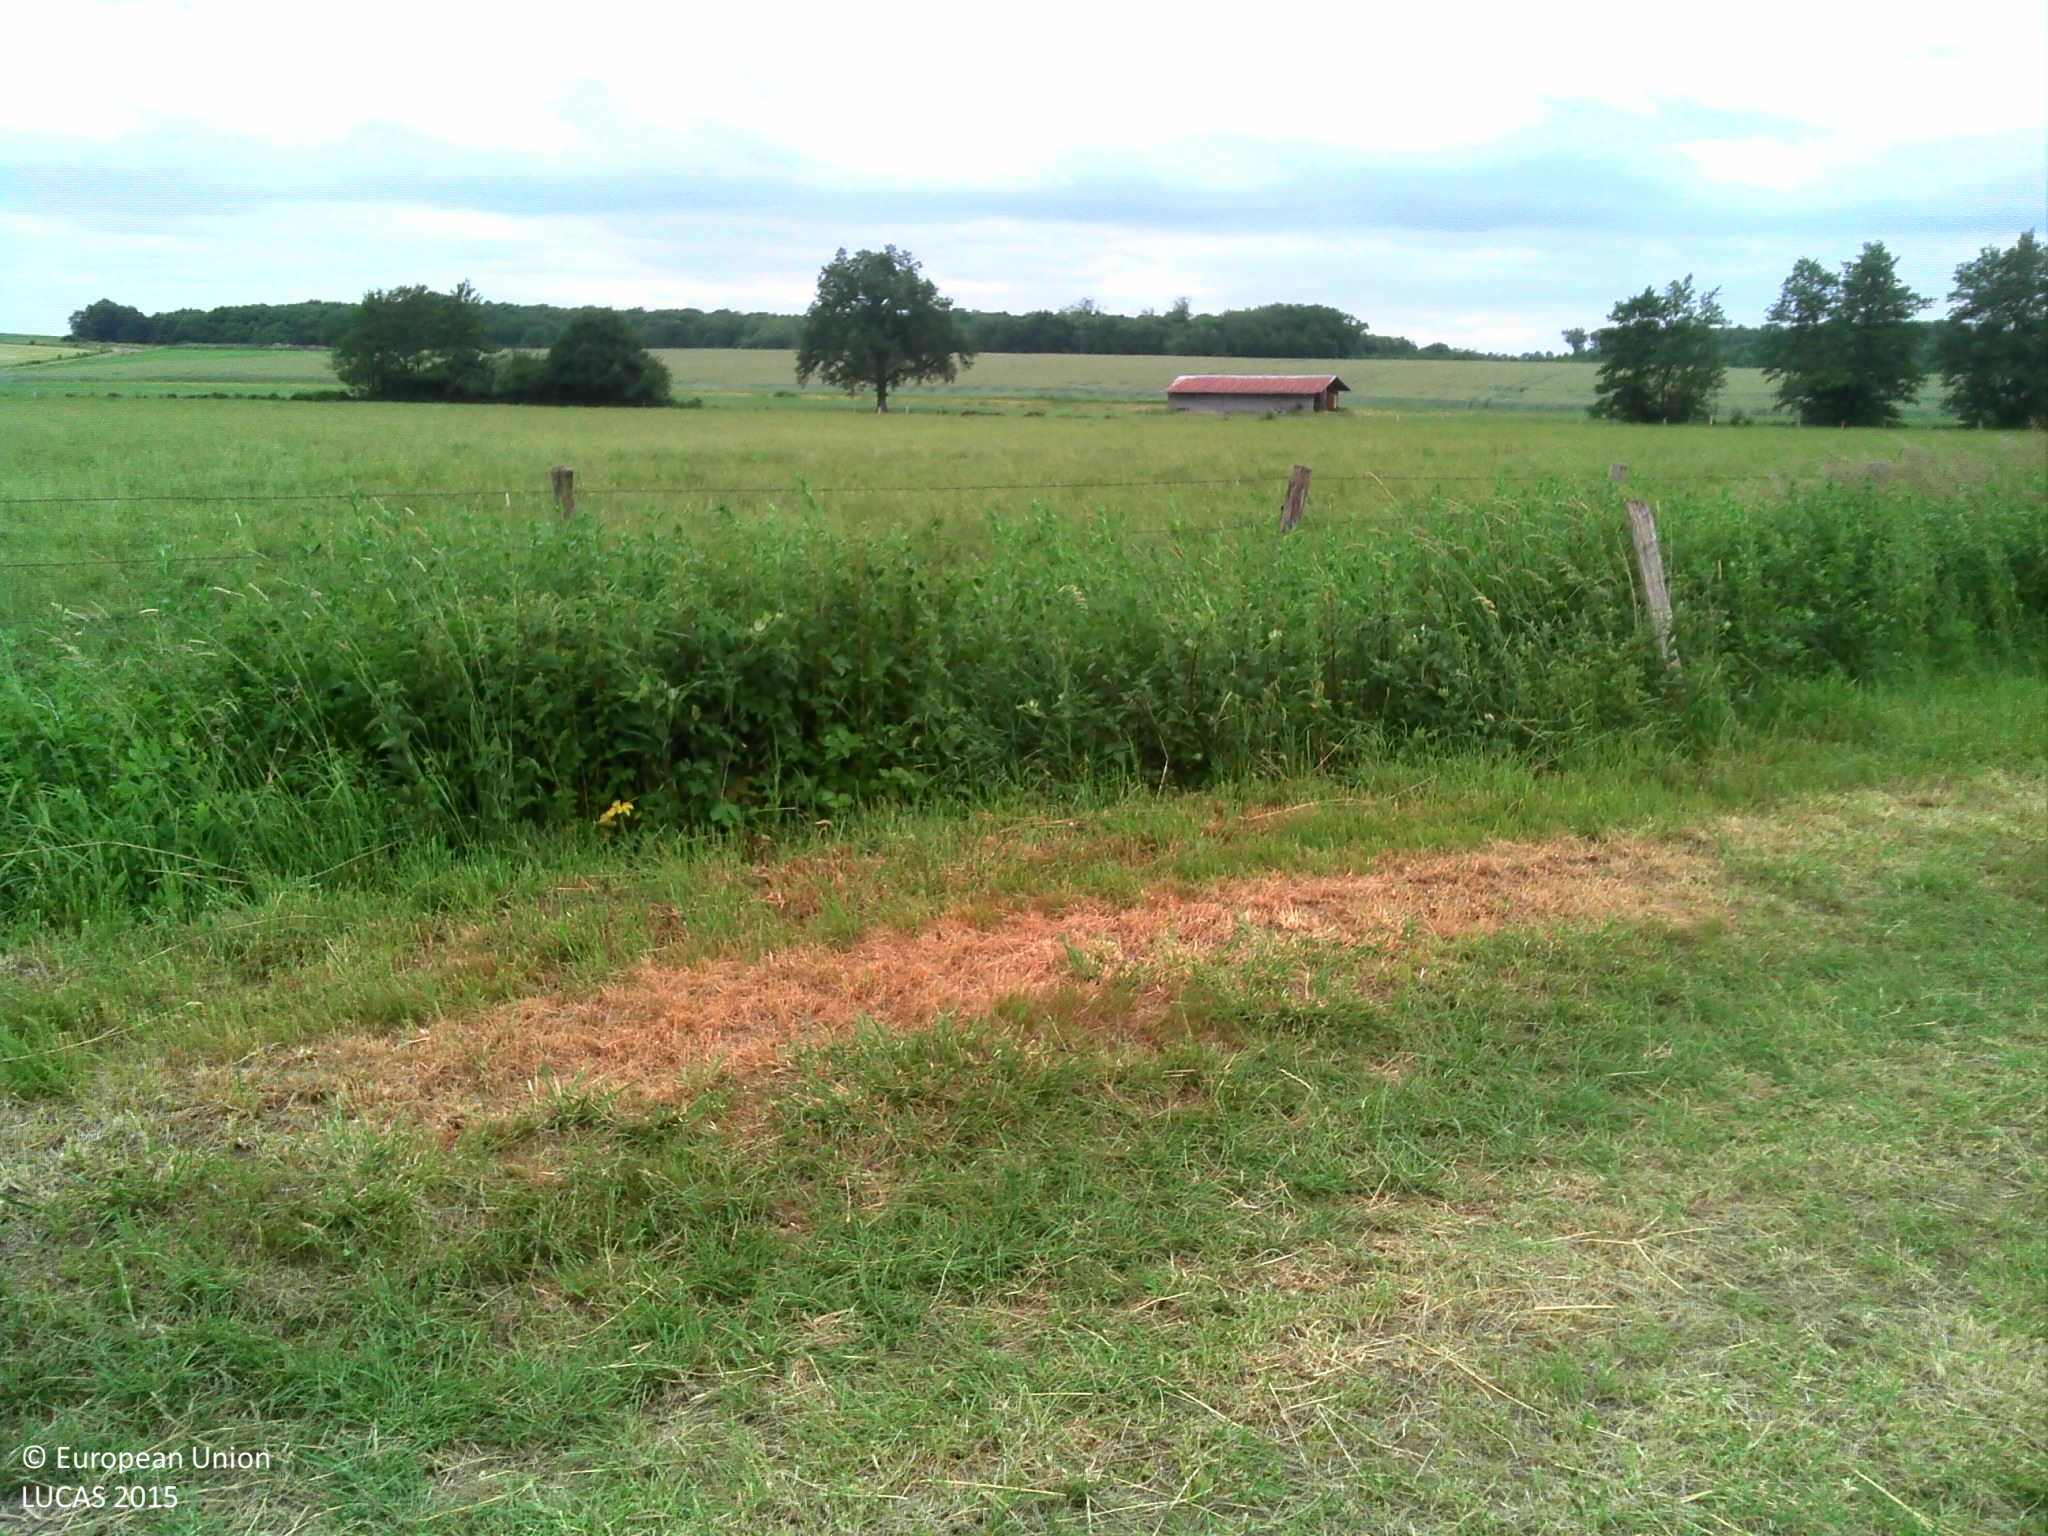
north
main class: Grassland
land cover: Grassland without tree/shrub cover
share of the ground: > 75 %
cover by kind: herbaceous plants 100 %
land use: Agriculture (excluding fallow land and kitchen gardens)
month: June
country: FR
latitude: 47.6233
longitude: 6.3688
